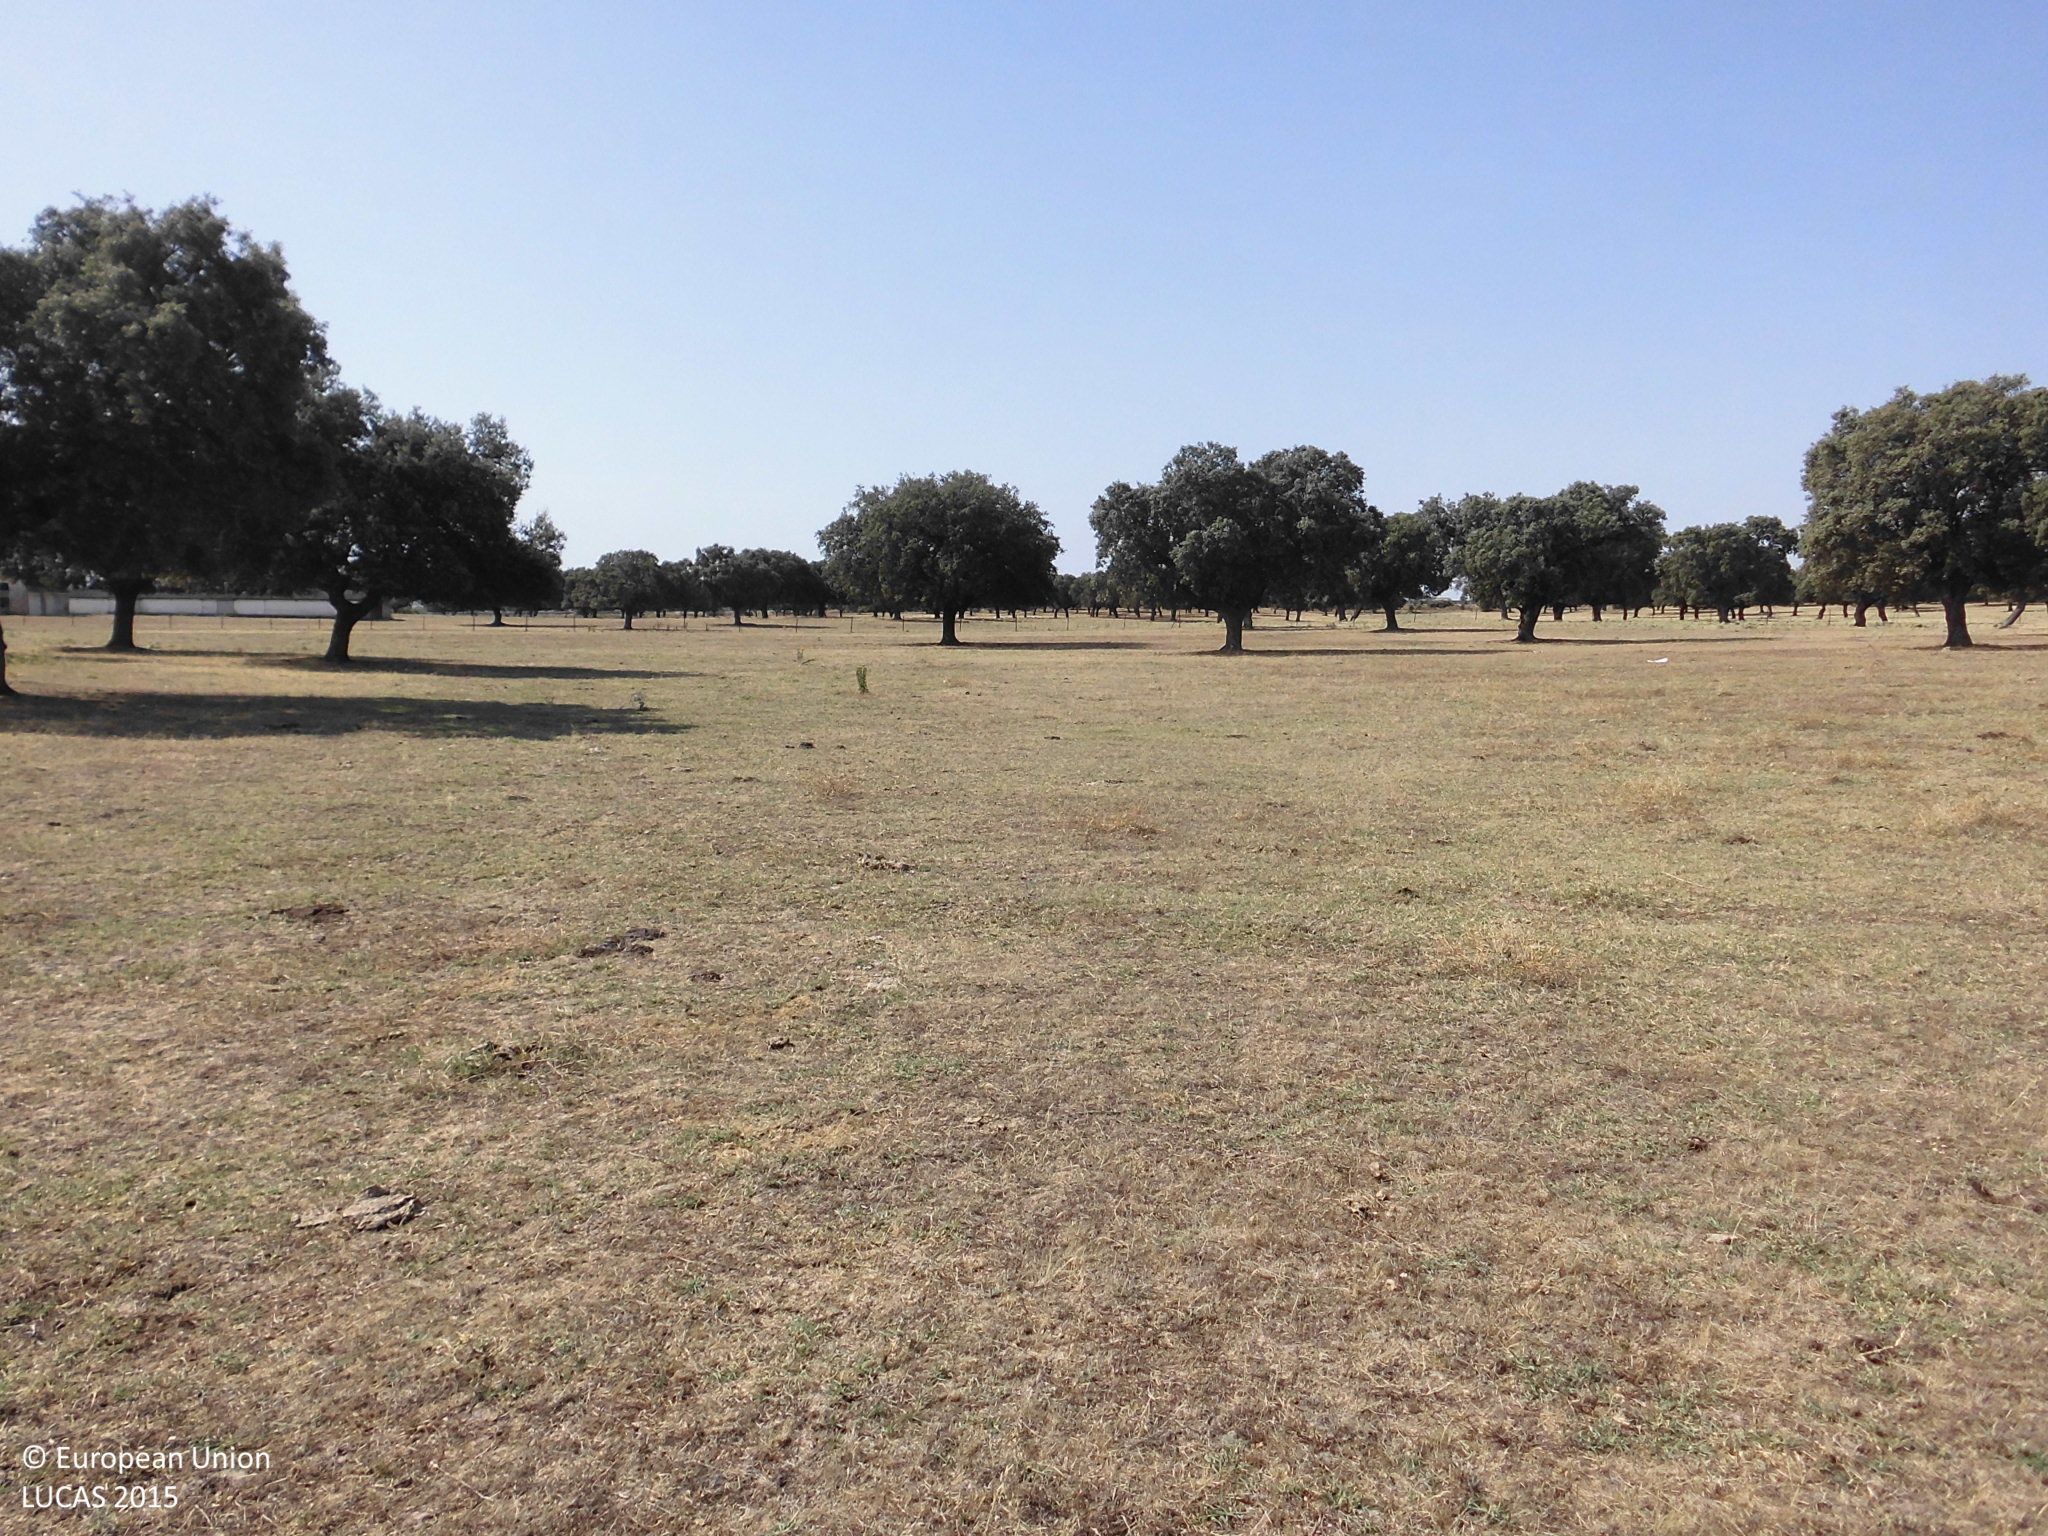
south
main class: Woodland
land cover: Broadleaved woodland
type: broadleaved evergreen forest
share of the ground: 10 - 25 %
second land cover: Grassland without tree/shrub cover
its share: > 75 %
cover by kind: herbaceous plants 90 %, broadleaved forest trees 10 %
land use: Forestry
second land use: Agriculture (excluding fallow land and kitchen gardens)
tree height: > 5 m
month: July
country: ES
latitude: 39.8937
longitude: -5.4838
